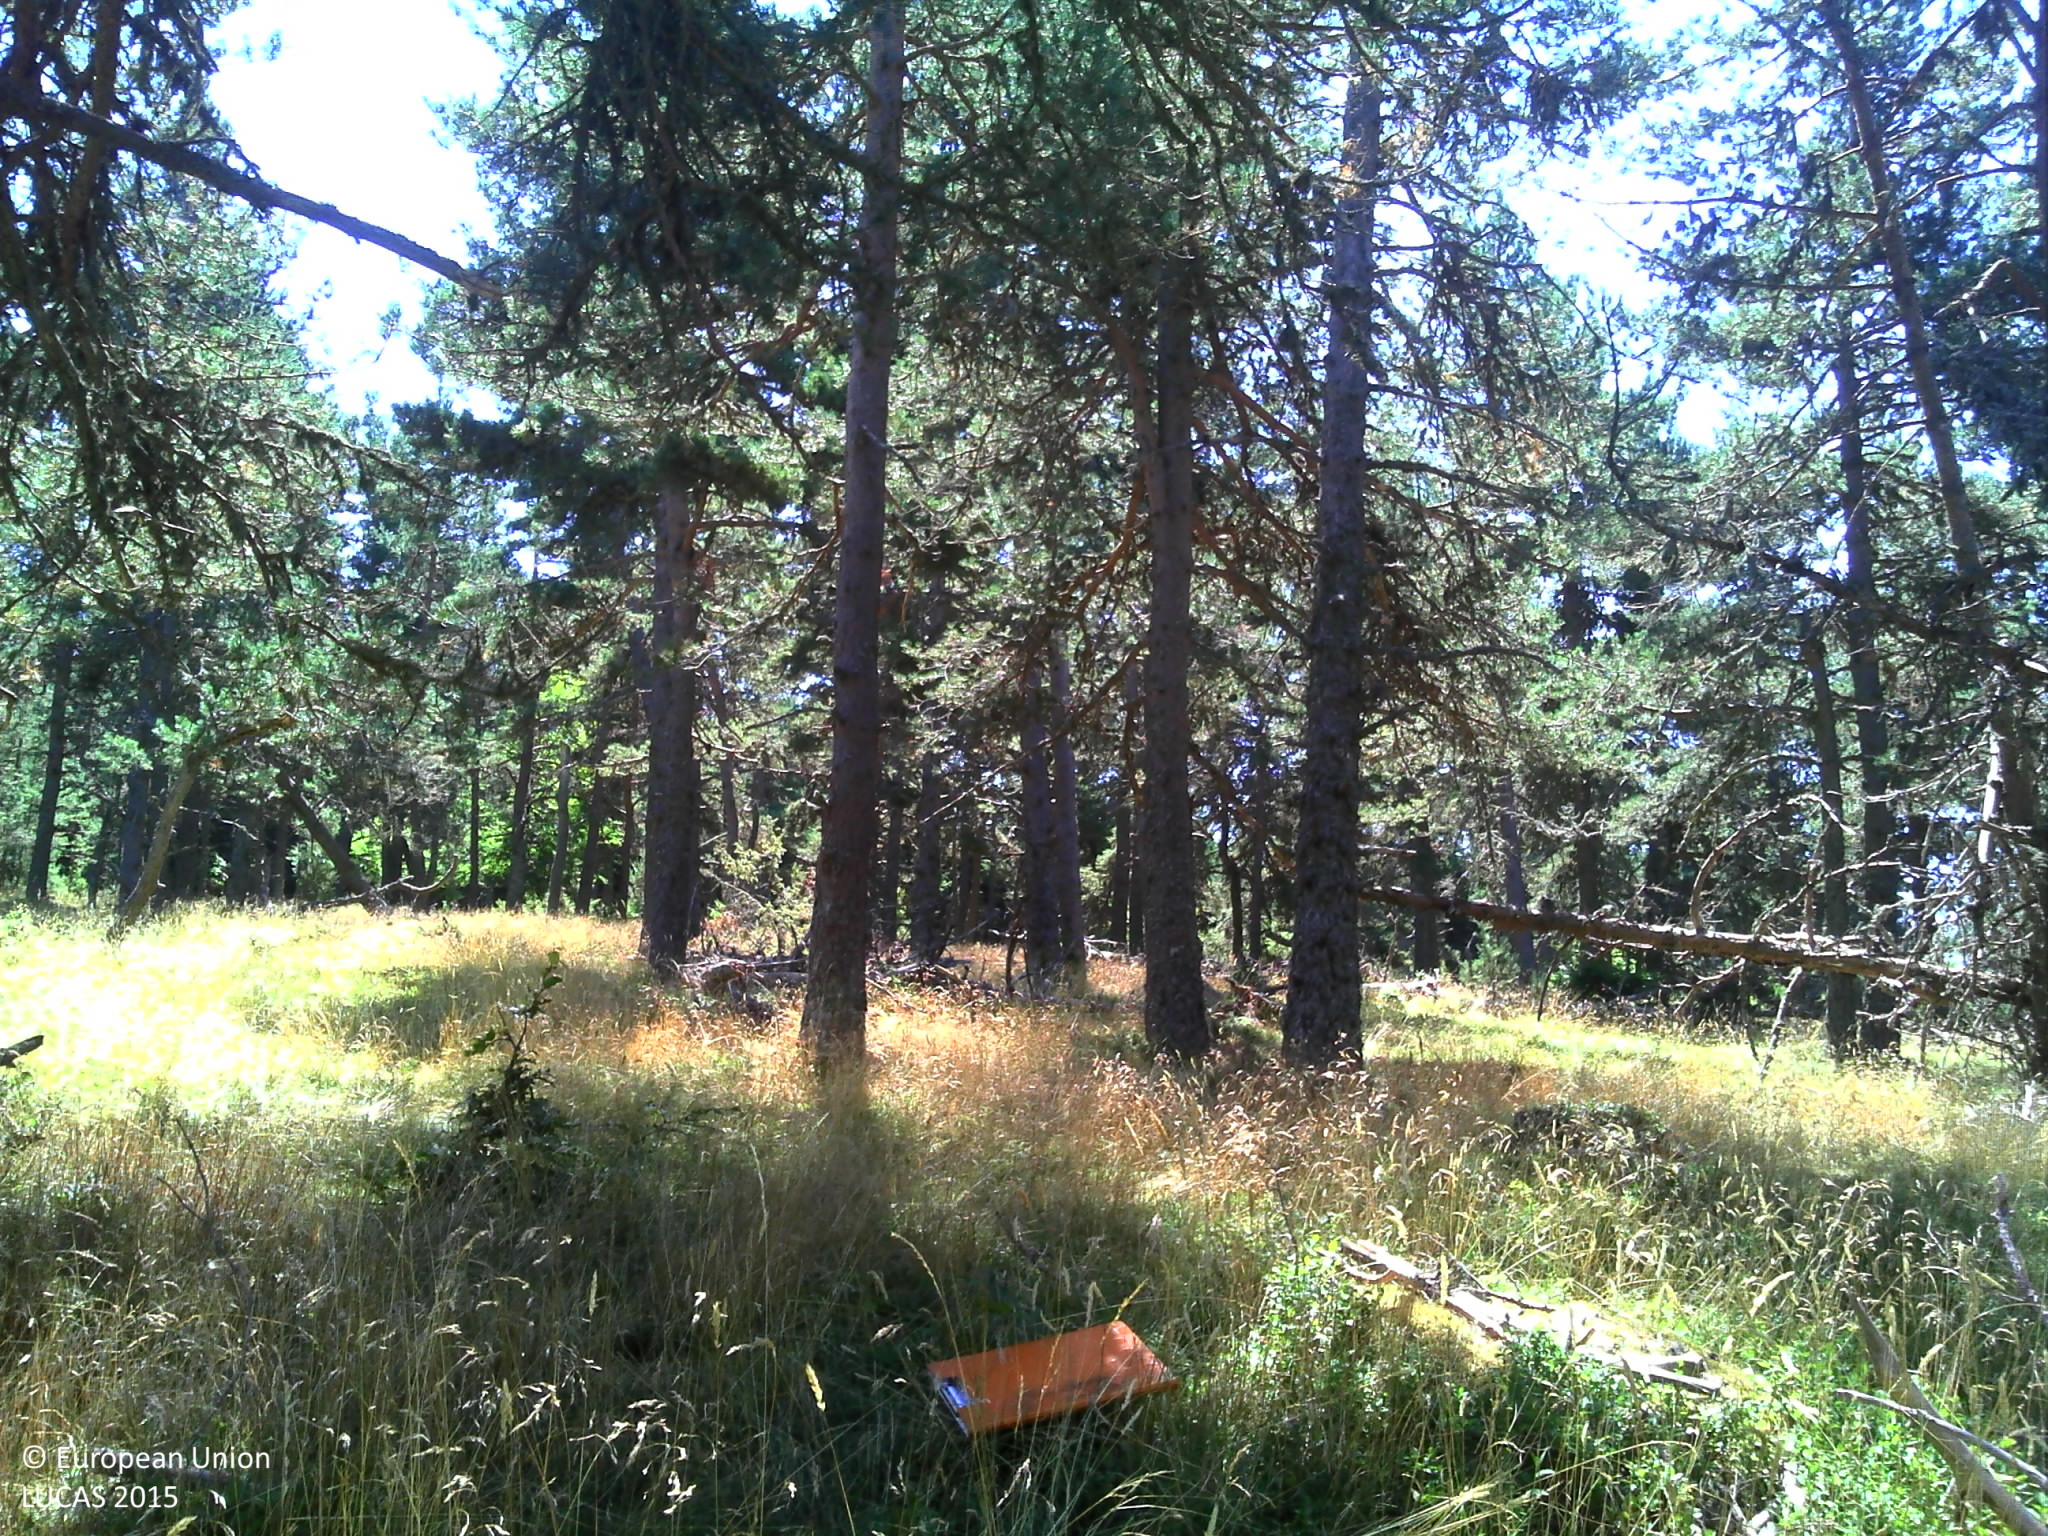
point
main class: Woodland
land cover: Pine dominated coniferous woodland
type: alpine coniferous forest
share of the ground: > 75 %
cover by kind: coniferous forest trees 95 %, broadleaved forest trees 5 %
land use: Agriculture (excluding fallow land and kitchen gardens)
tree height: > 5 m
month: August
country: FR
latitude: 44.6733
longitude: 3.5335
